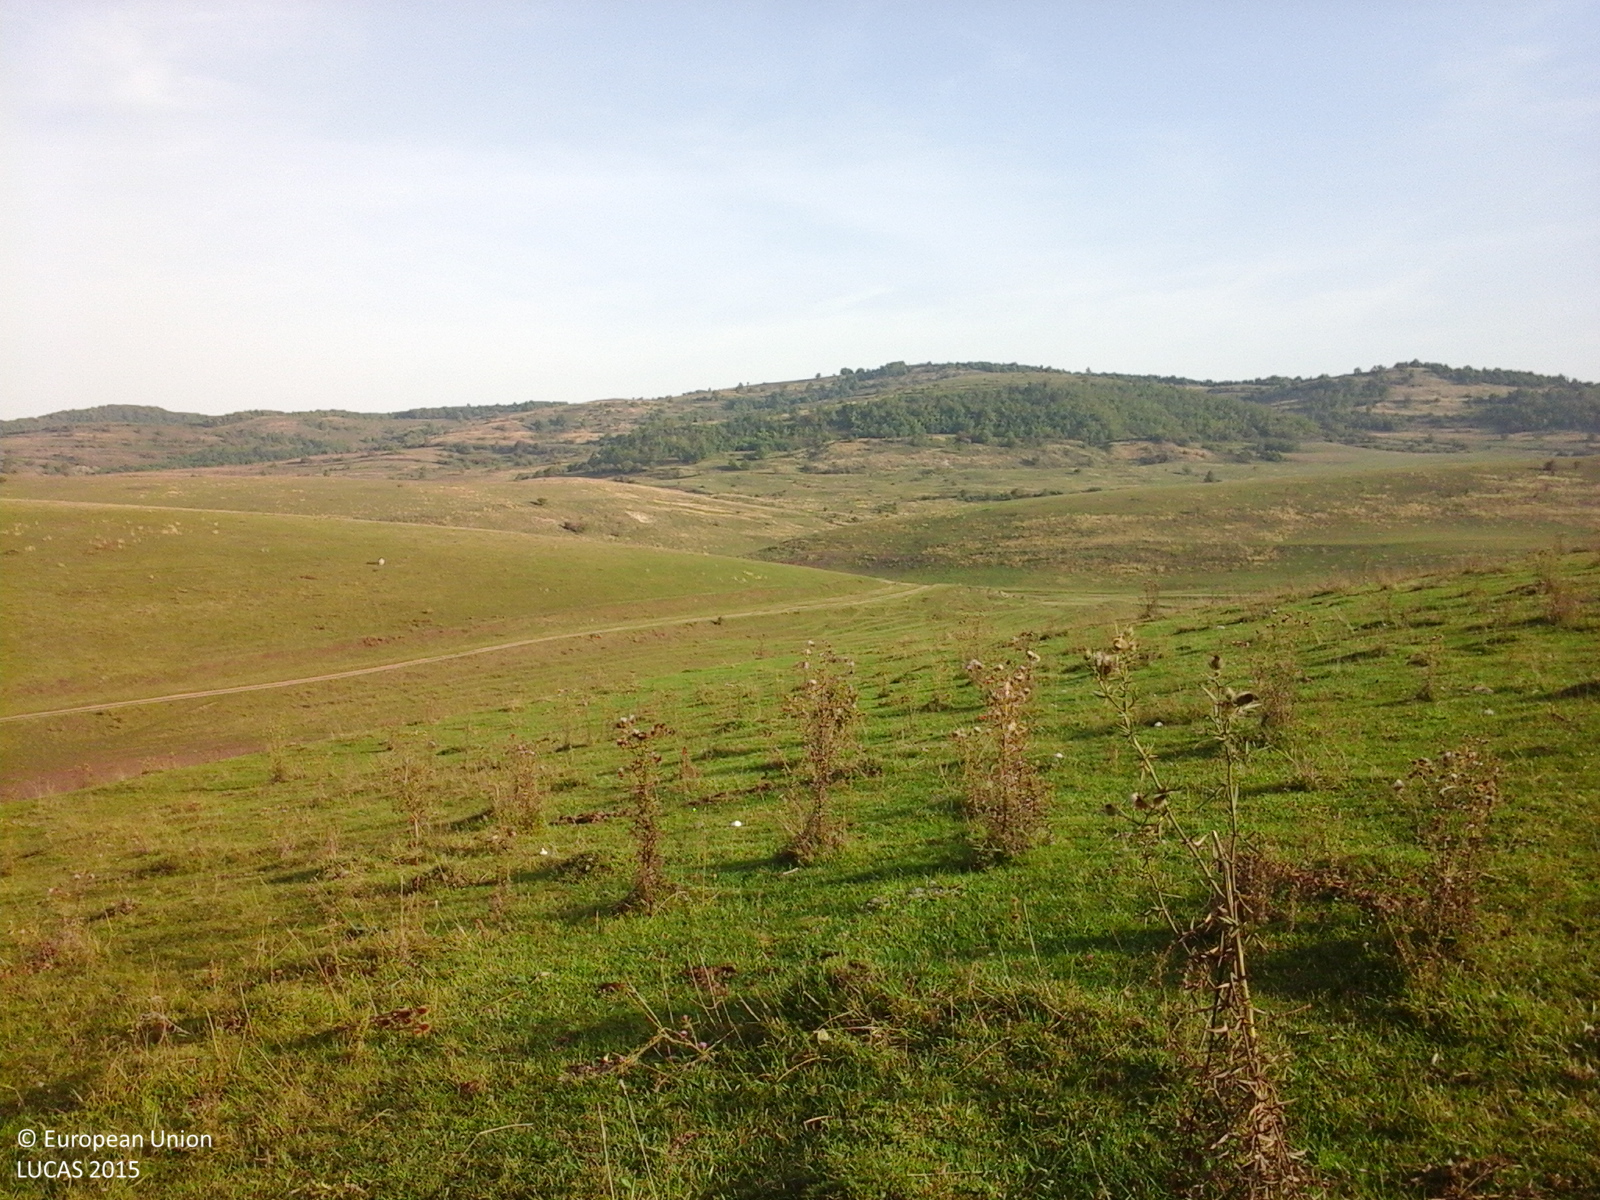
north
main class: Grassland
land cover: Grassland without tree/shrub cover
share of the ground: > 75 %
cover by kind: herbaceous plants 100 %
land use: Agriculture (excluding fallow land and kitchen gardens)
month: September
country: RO
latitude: 46.8384
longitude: 23.3761
